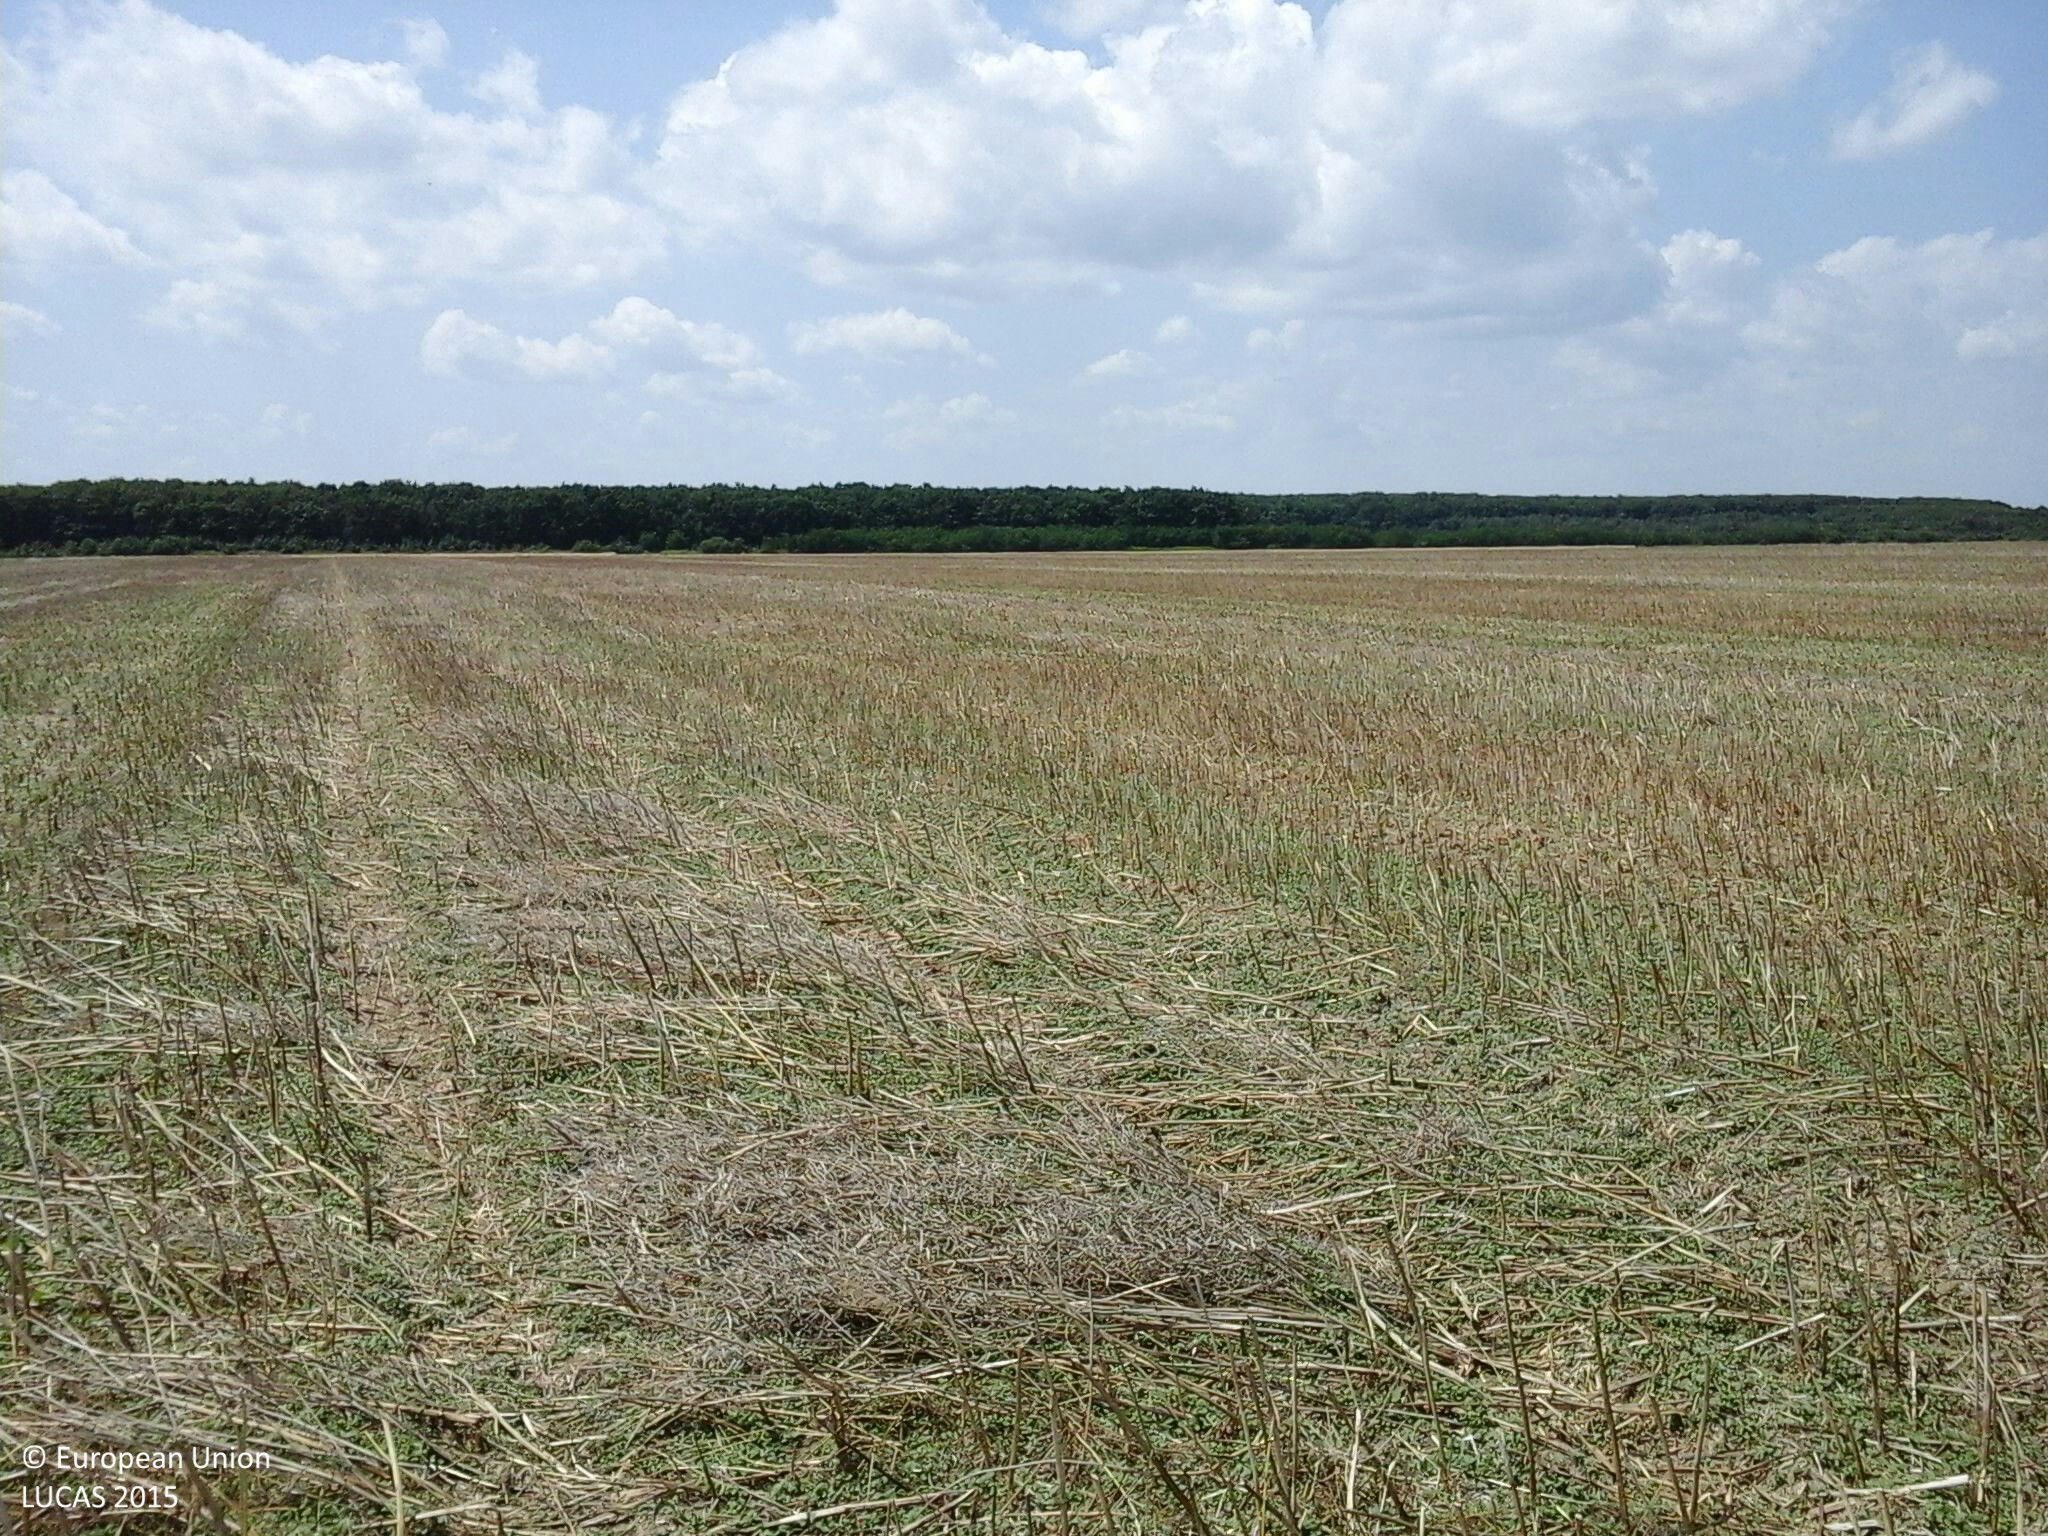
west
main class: Cropland
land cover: Rape and turnip rape
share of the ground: < 10 %
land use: Agriculture (excluding fallow land and kitchen gardens)
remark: Harvested field
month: July
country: HU
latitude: 47.0817
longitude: 16.6811
